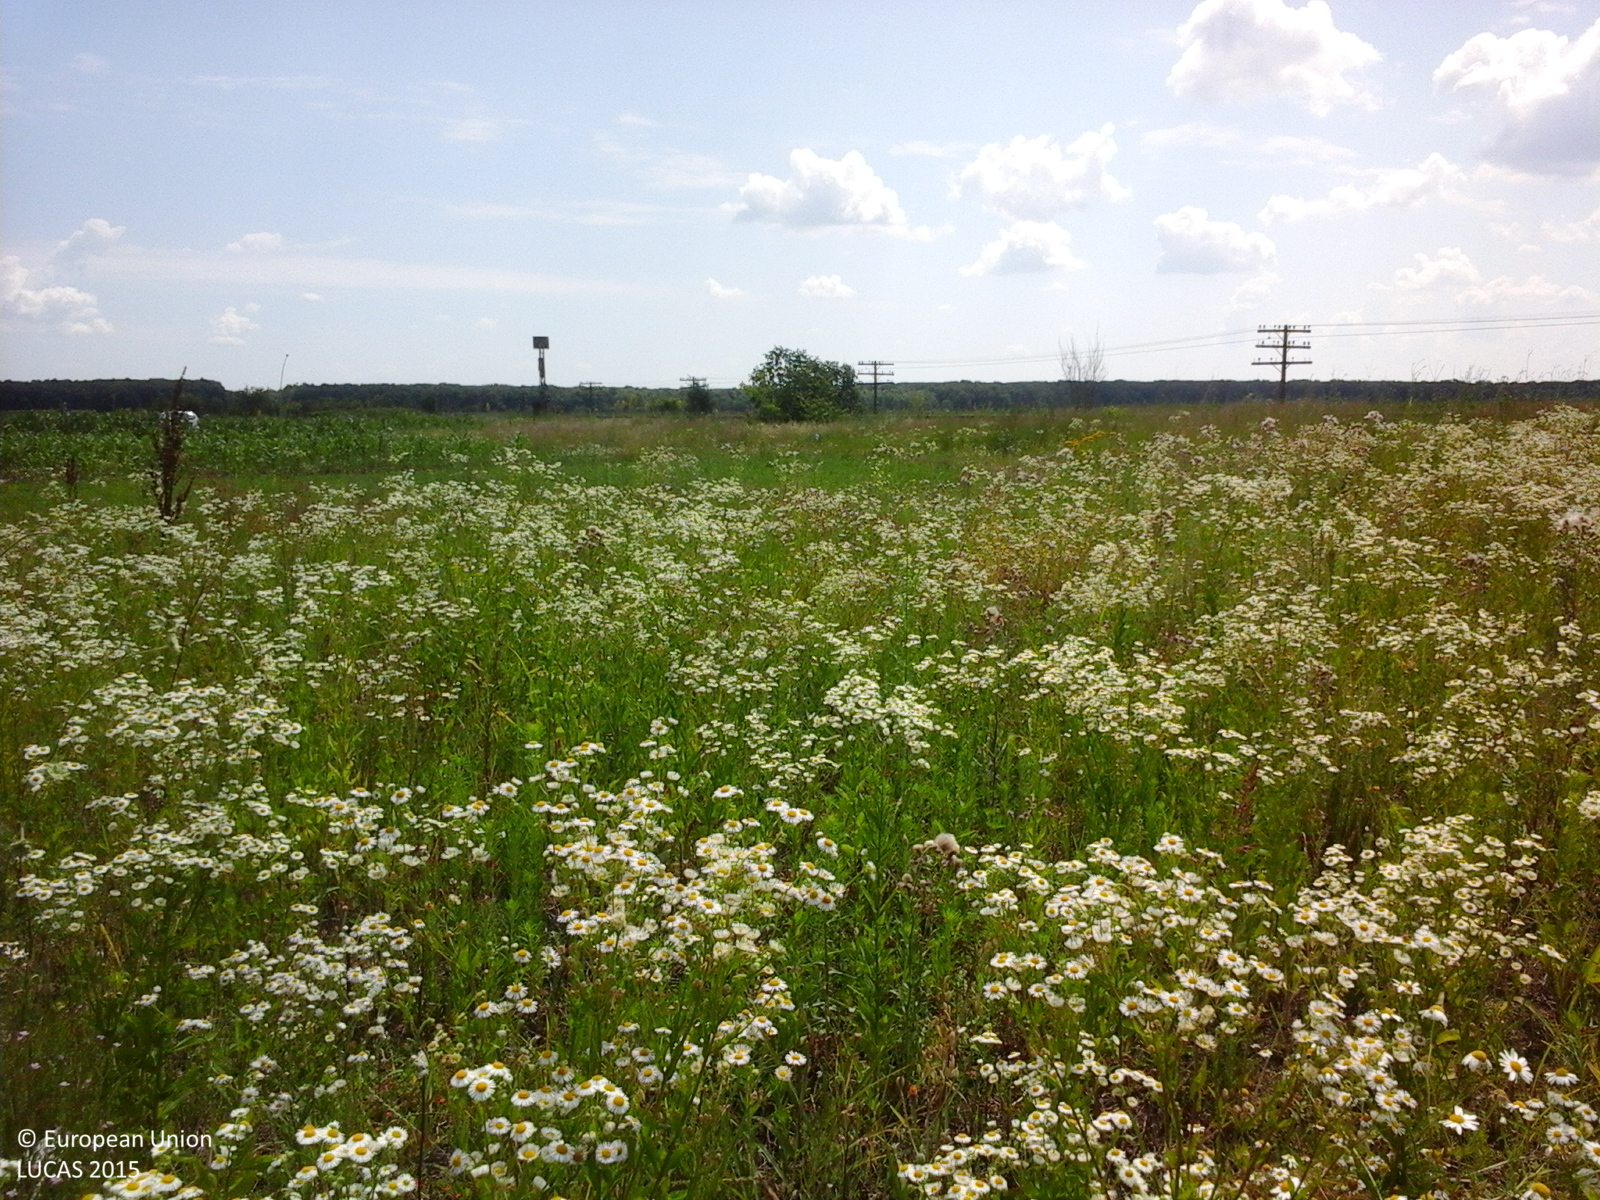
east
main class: Grassland
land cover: Spontaneously vegetated surfaces
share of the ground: > 75 %
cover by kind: herbaceous plants 100 %
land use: Agriculture (excluding fallow land and kitchen gardens)
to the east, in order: Spontaneously vegetated surfaces; Tracks; Lucerne; Spontaneously vegetated surfaces; Railways; Grassland without tree/shrub cover; Tracks; Grassland without tree/shrub cover; Electric lines; Tracks; Grass margins; Maize; Common wheat
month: June
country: RO
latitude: 44.6412
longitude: 26.2354
